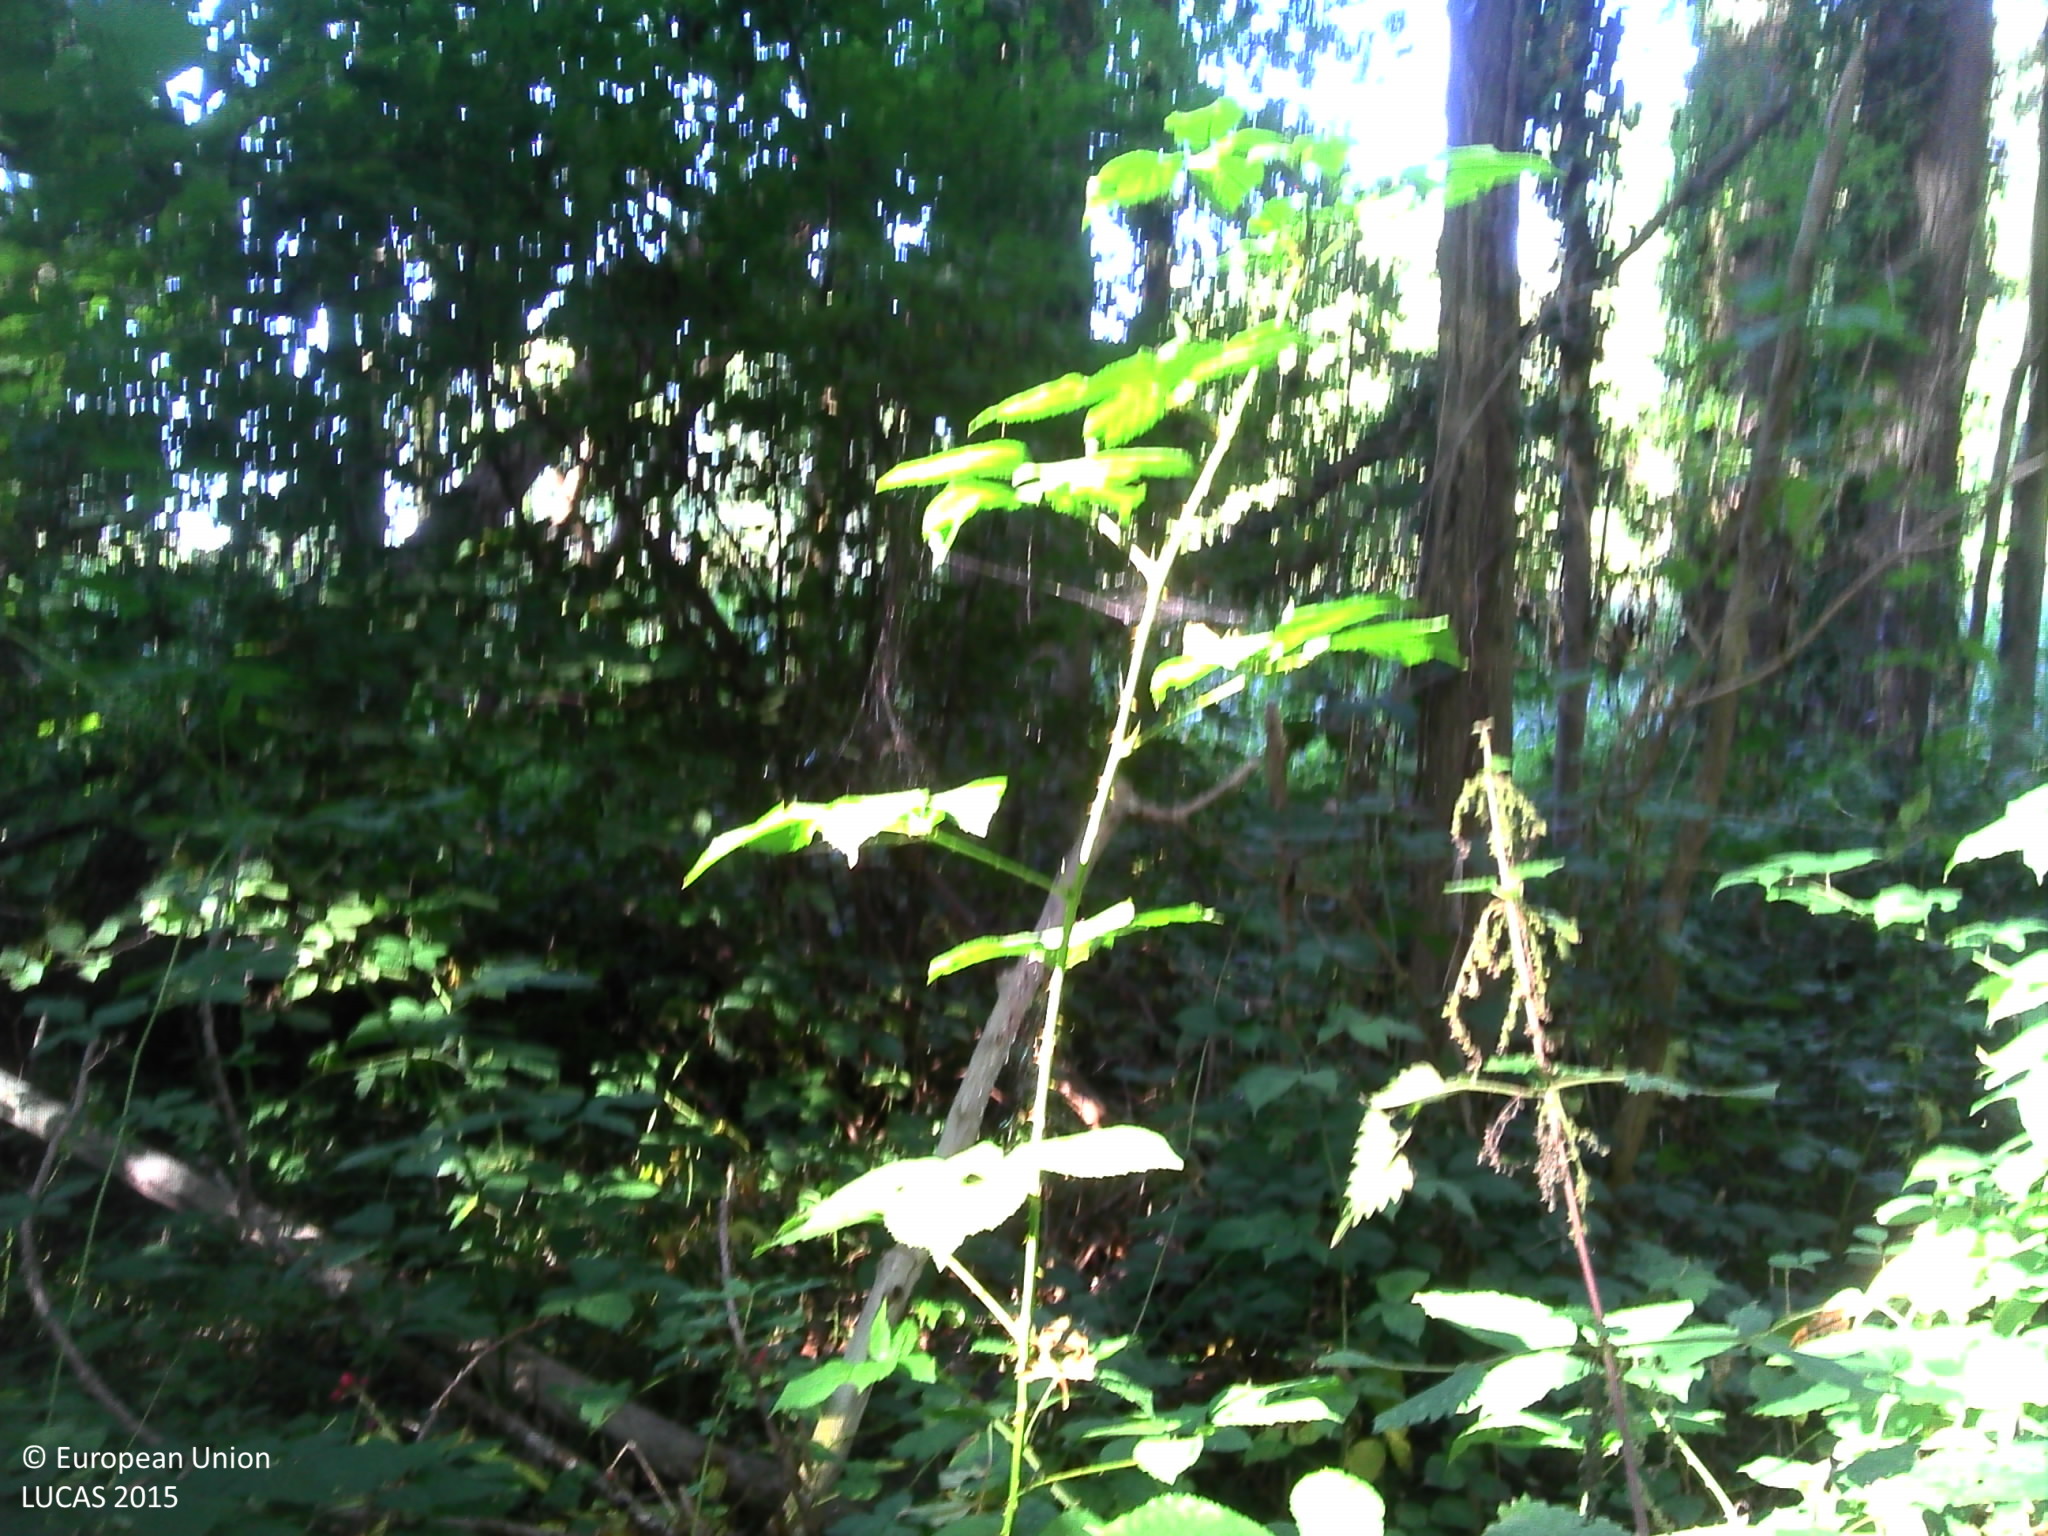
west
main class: Woodland
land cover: Broadleaved woodland
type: non-riverine alder, birch or aspen forest
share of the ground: > 75 %
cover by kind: broadleaved forest trees 95 %, herbaceous plants 5 %
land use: Forestry
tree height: > 5 m
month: September
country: BE
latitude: 51.2162
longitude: 4.7423
